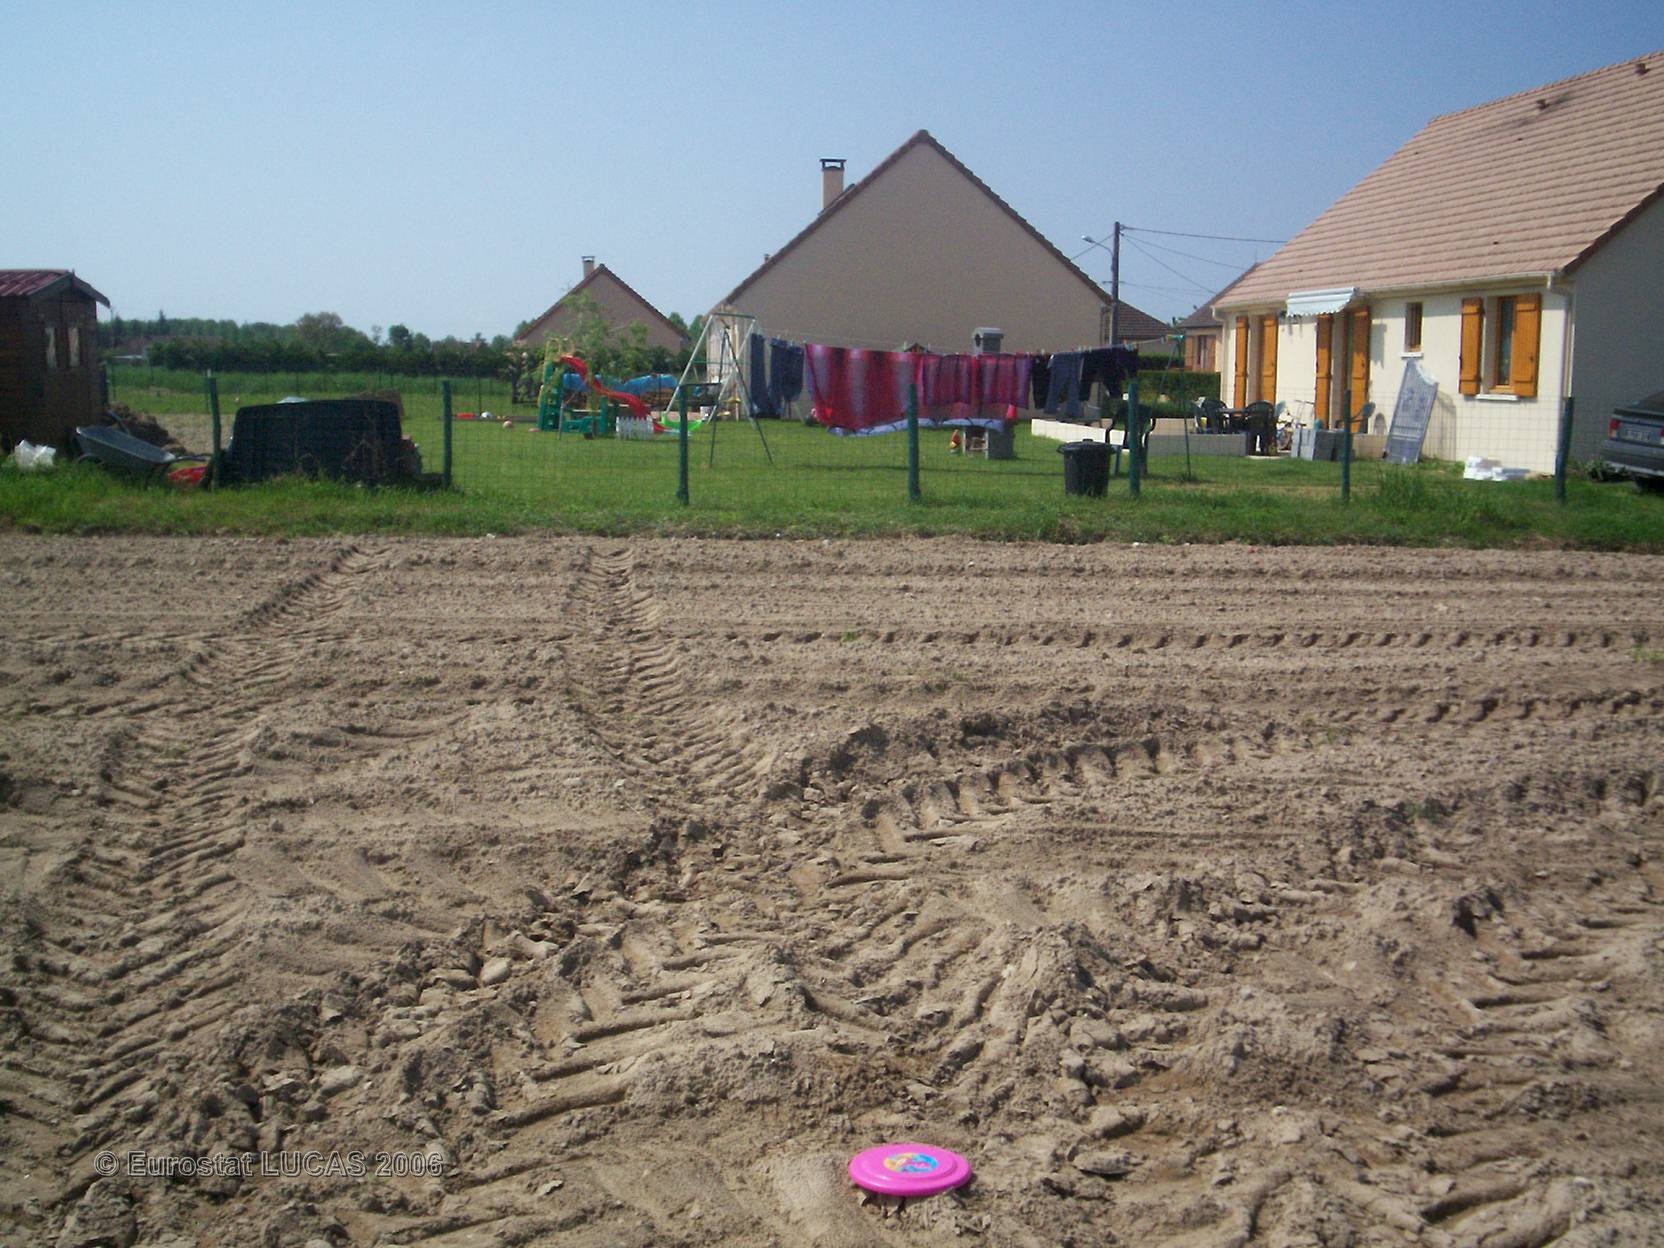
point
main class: Cropland
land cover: Maize
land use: Agriculture (excluding fallow land and kitchen gardens)
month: May
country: FR
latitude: 47.7827
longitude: 0.1645
